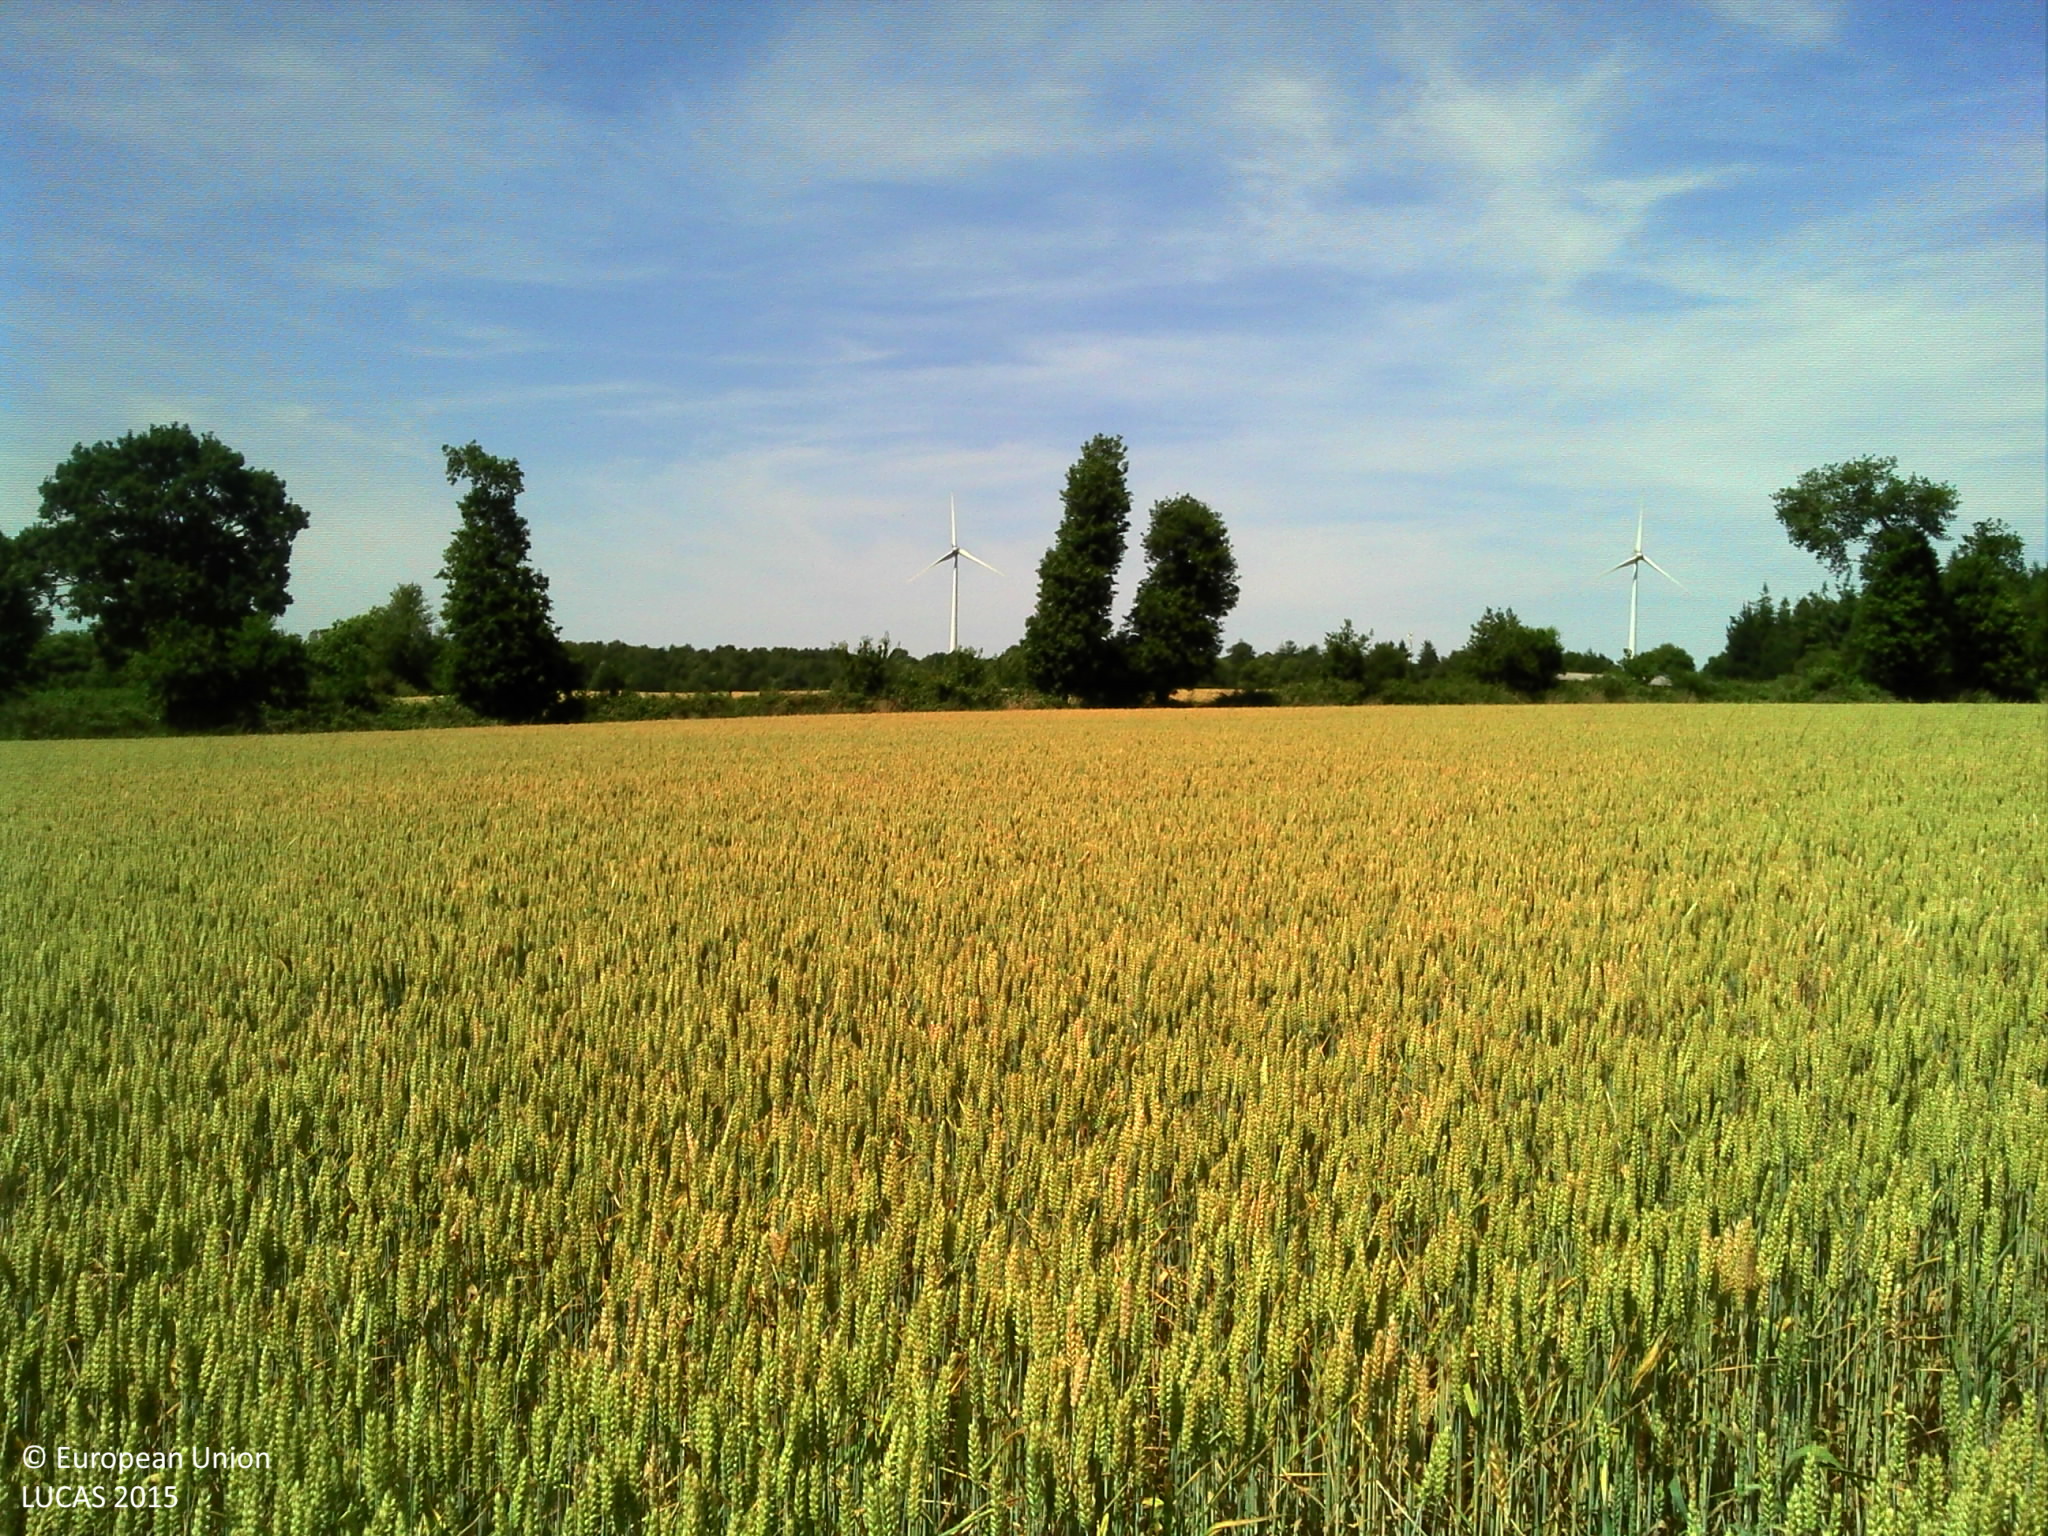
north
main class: Cropland
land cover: Common wheat
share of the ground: > 75 %
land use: Agriculture (excluding fallow land and kitchen gardens)
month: June
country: FR
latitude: 48.0115
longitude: -2.0780
